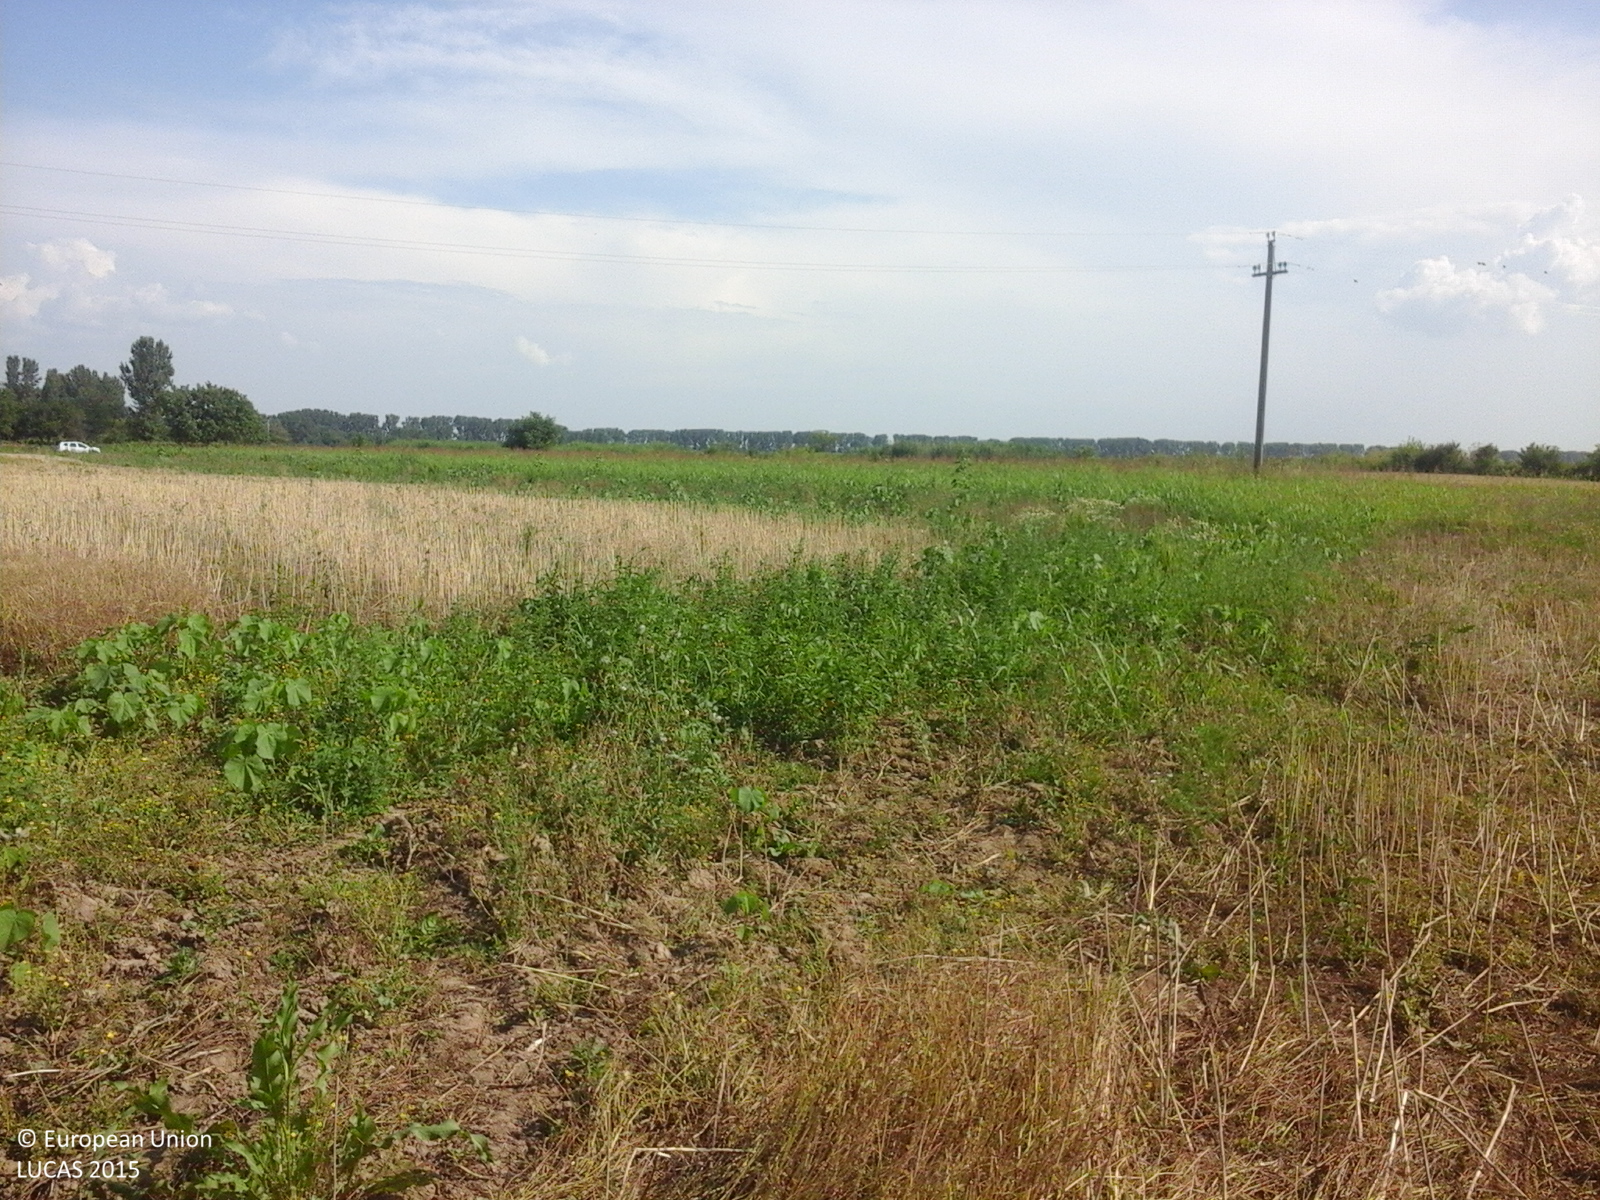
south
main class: Grassland
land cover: Spontaneously vegetated surfaces
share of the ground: > 75 %
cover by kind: herbaceous plants 100 %
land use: Fallow land
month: July
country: RO
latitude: 44.0014
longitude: 26.1011
